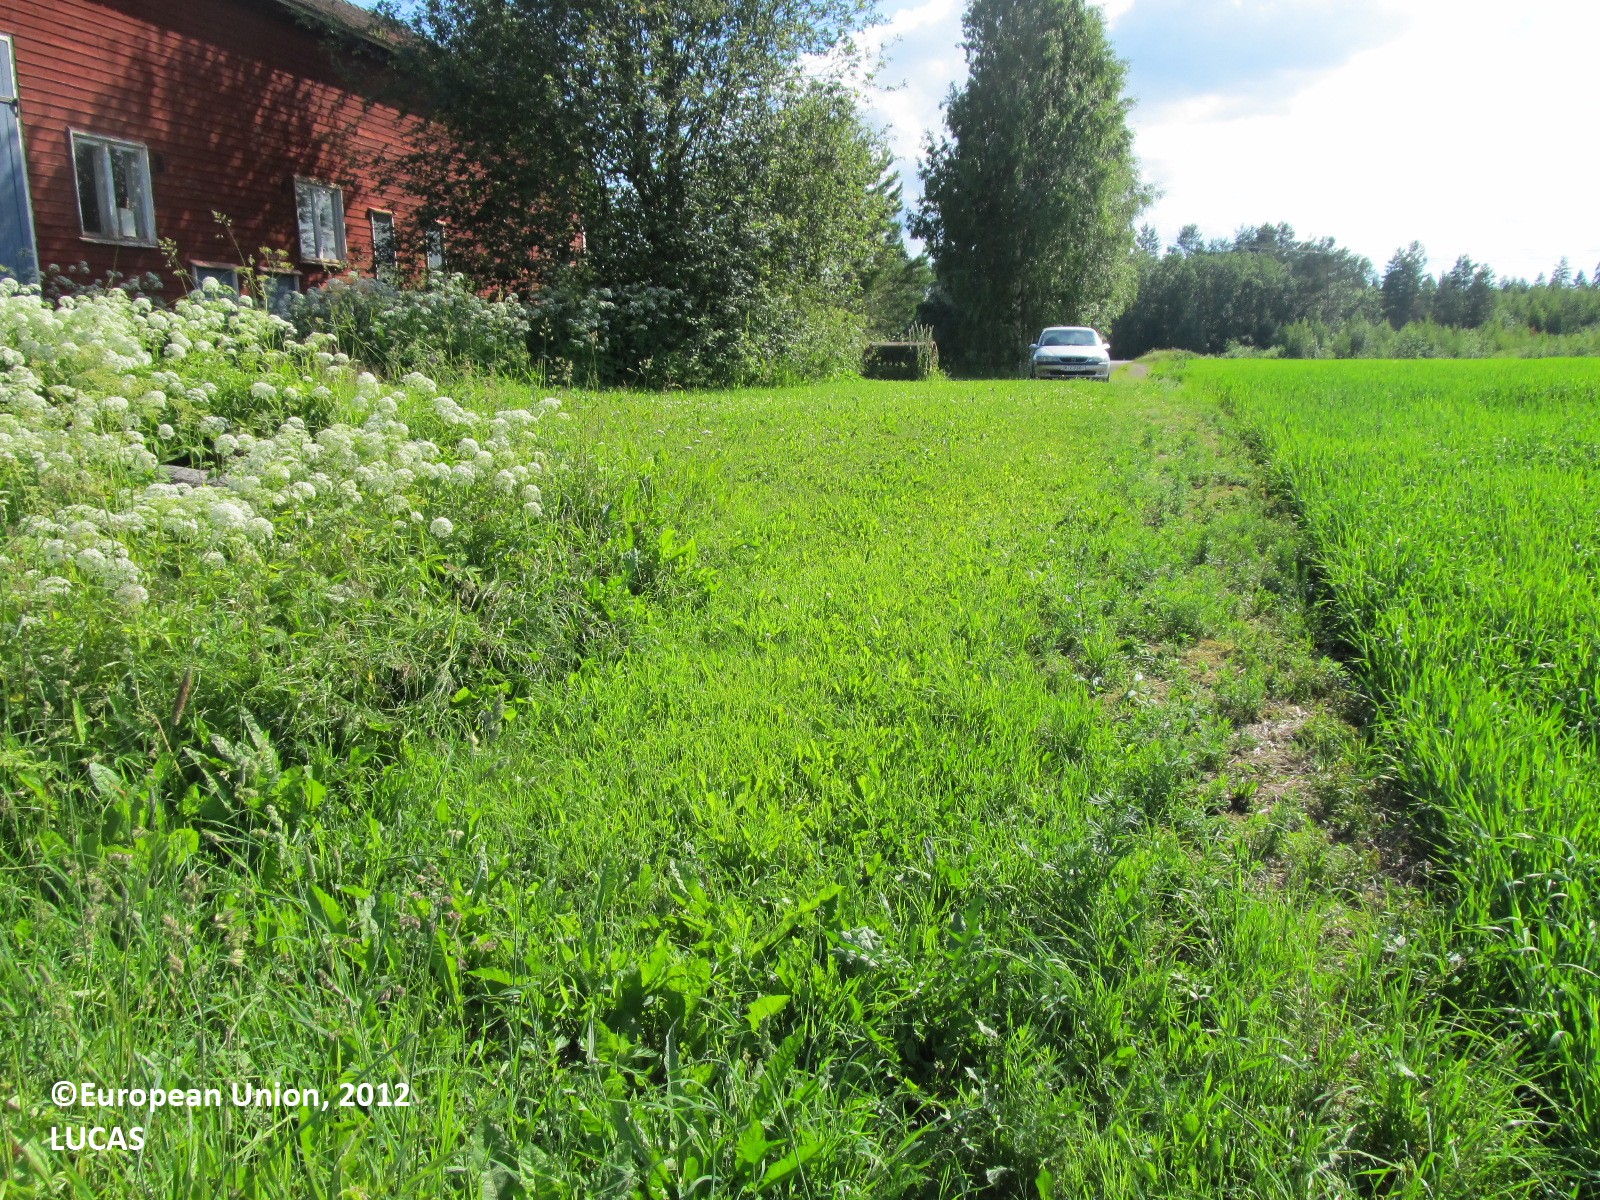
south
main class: Cropland
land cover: Barley
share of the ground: 50 - 75 %
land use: Agriculture (excluding fallow land and kitchen gardens)
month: July
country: FI
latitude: 61.9576
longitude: 28.4528
